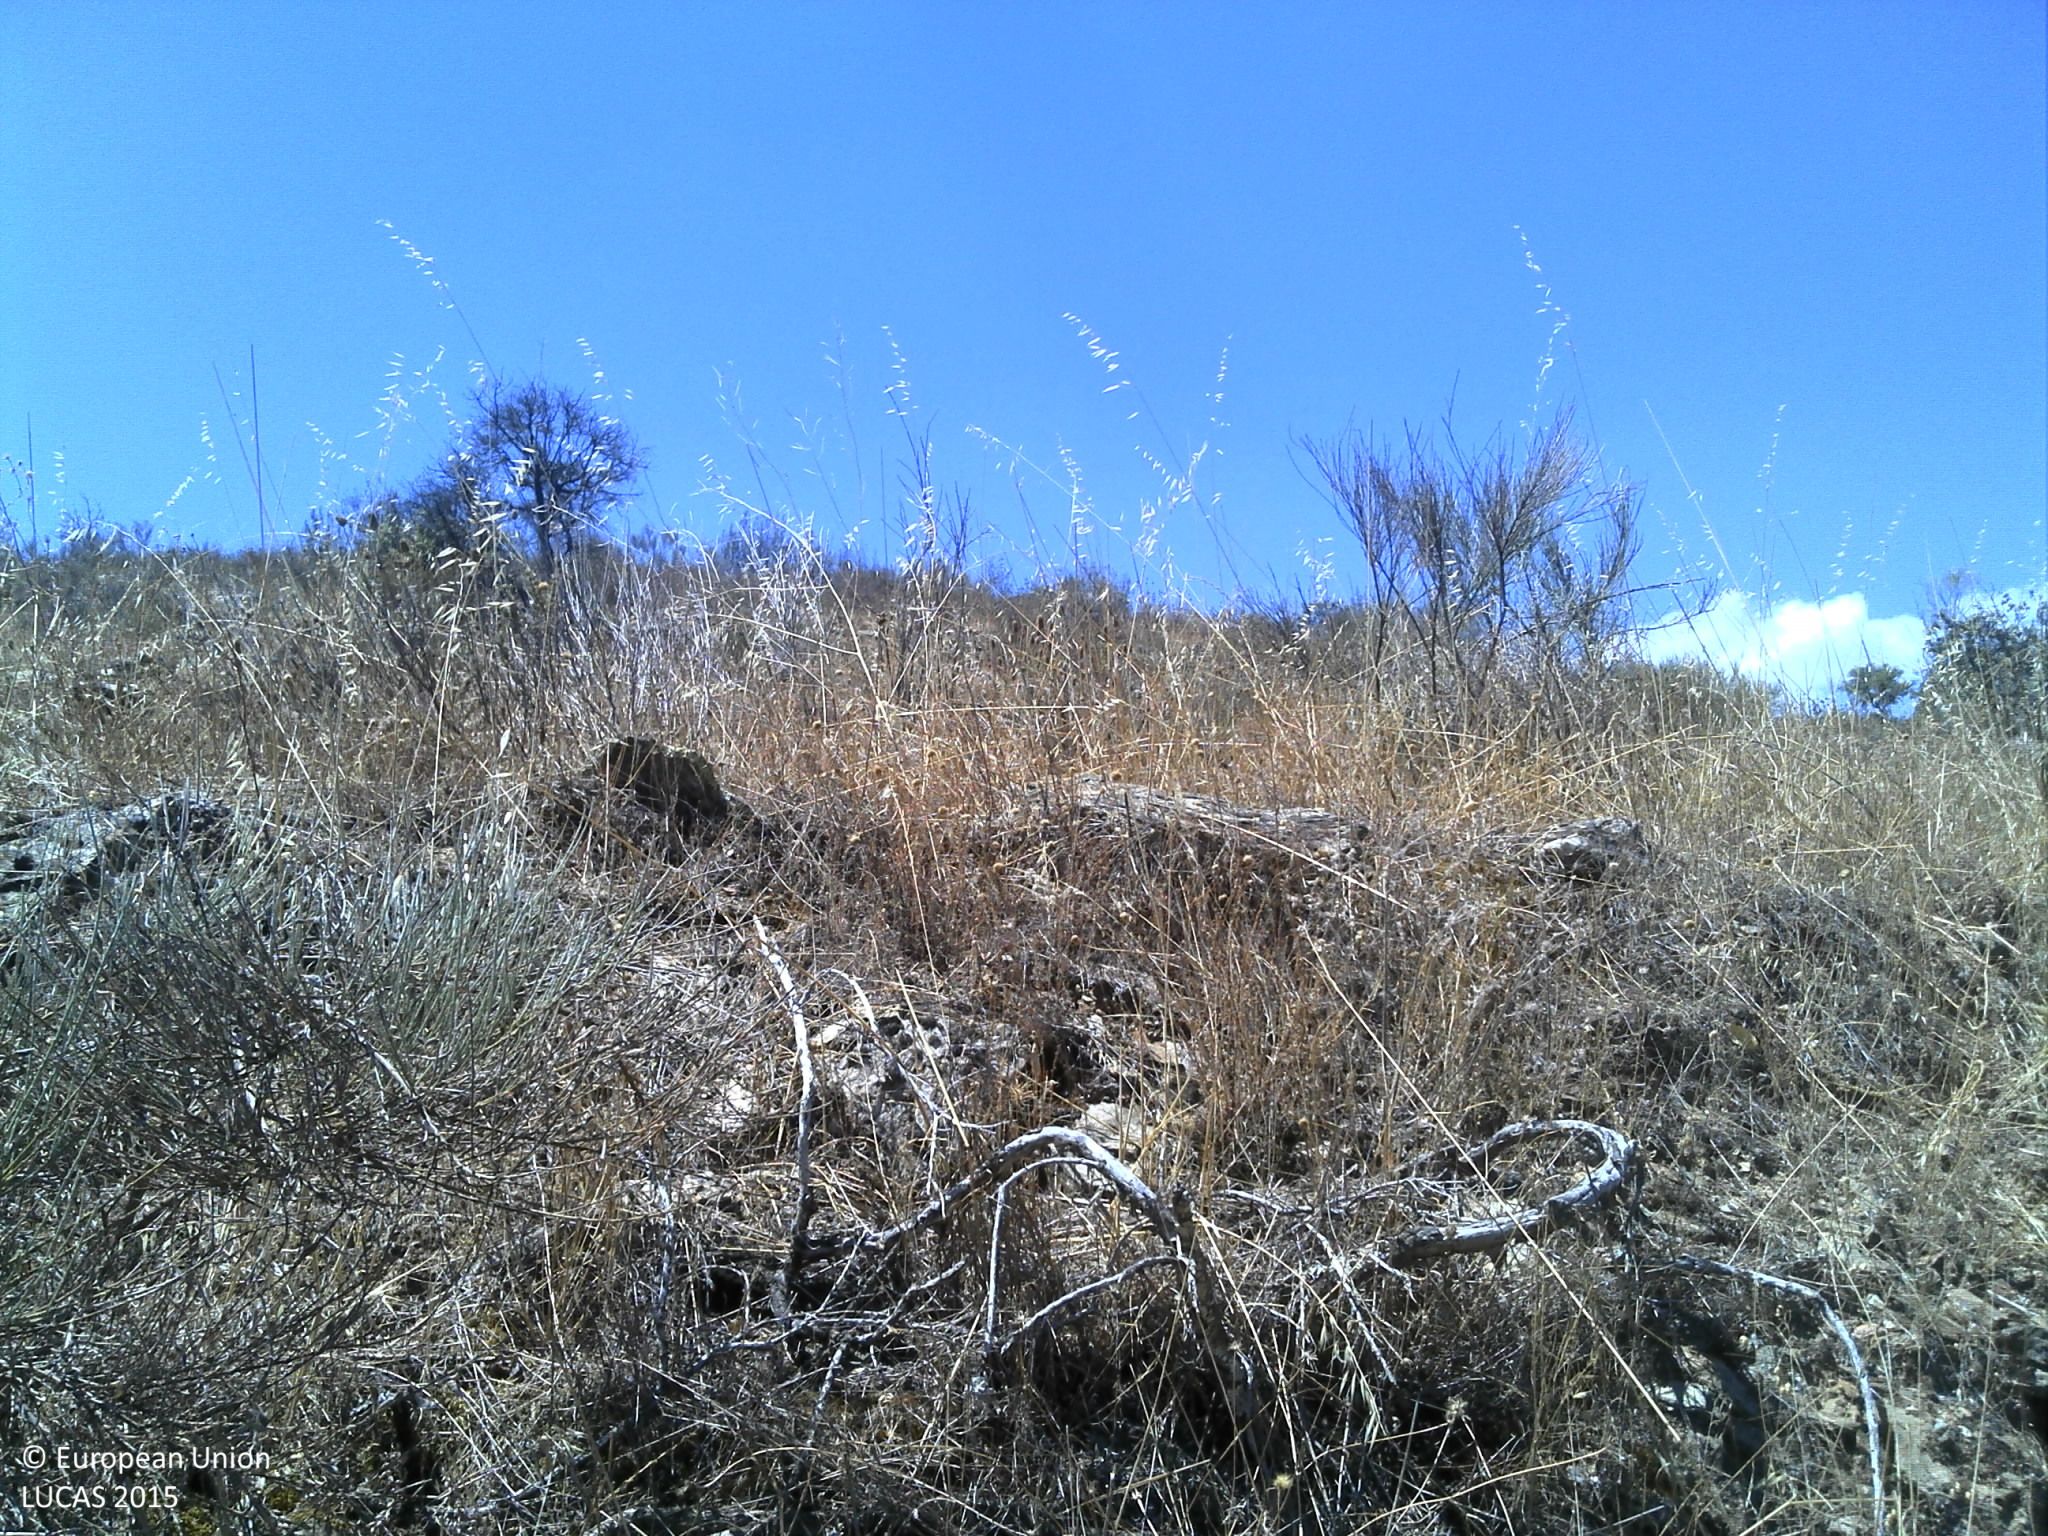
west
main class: Shrubland
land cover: Shrubland with sparse tree cover
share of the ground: > 75 %
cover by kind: shrubs 65 %, unconsolidated bare surface 20 %, herbaceous plants 10 %, broadleaved forest trees 5 %
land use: Abandoned areas
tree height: > 5 m
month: July
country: PT
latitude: 41.3652
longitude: -7.0291
